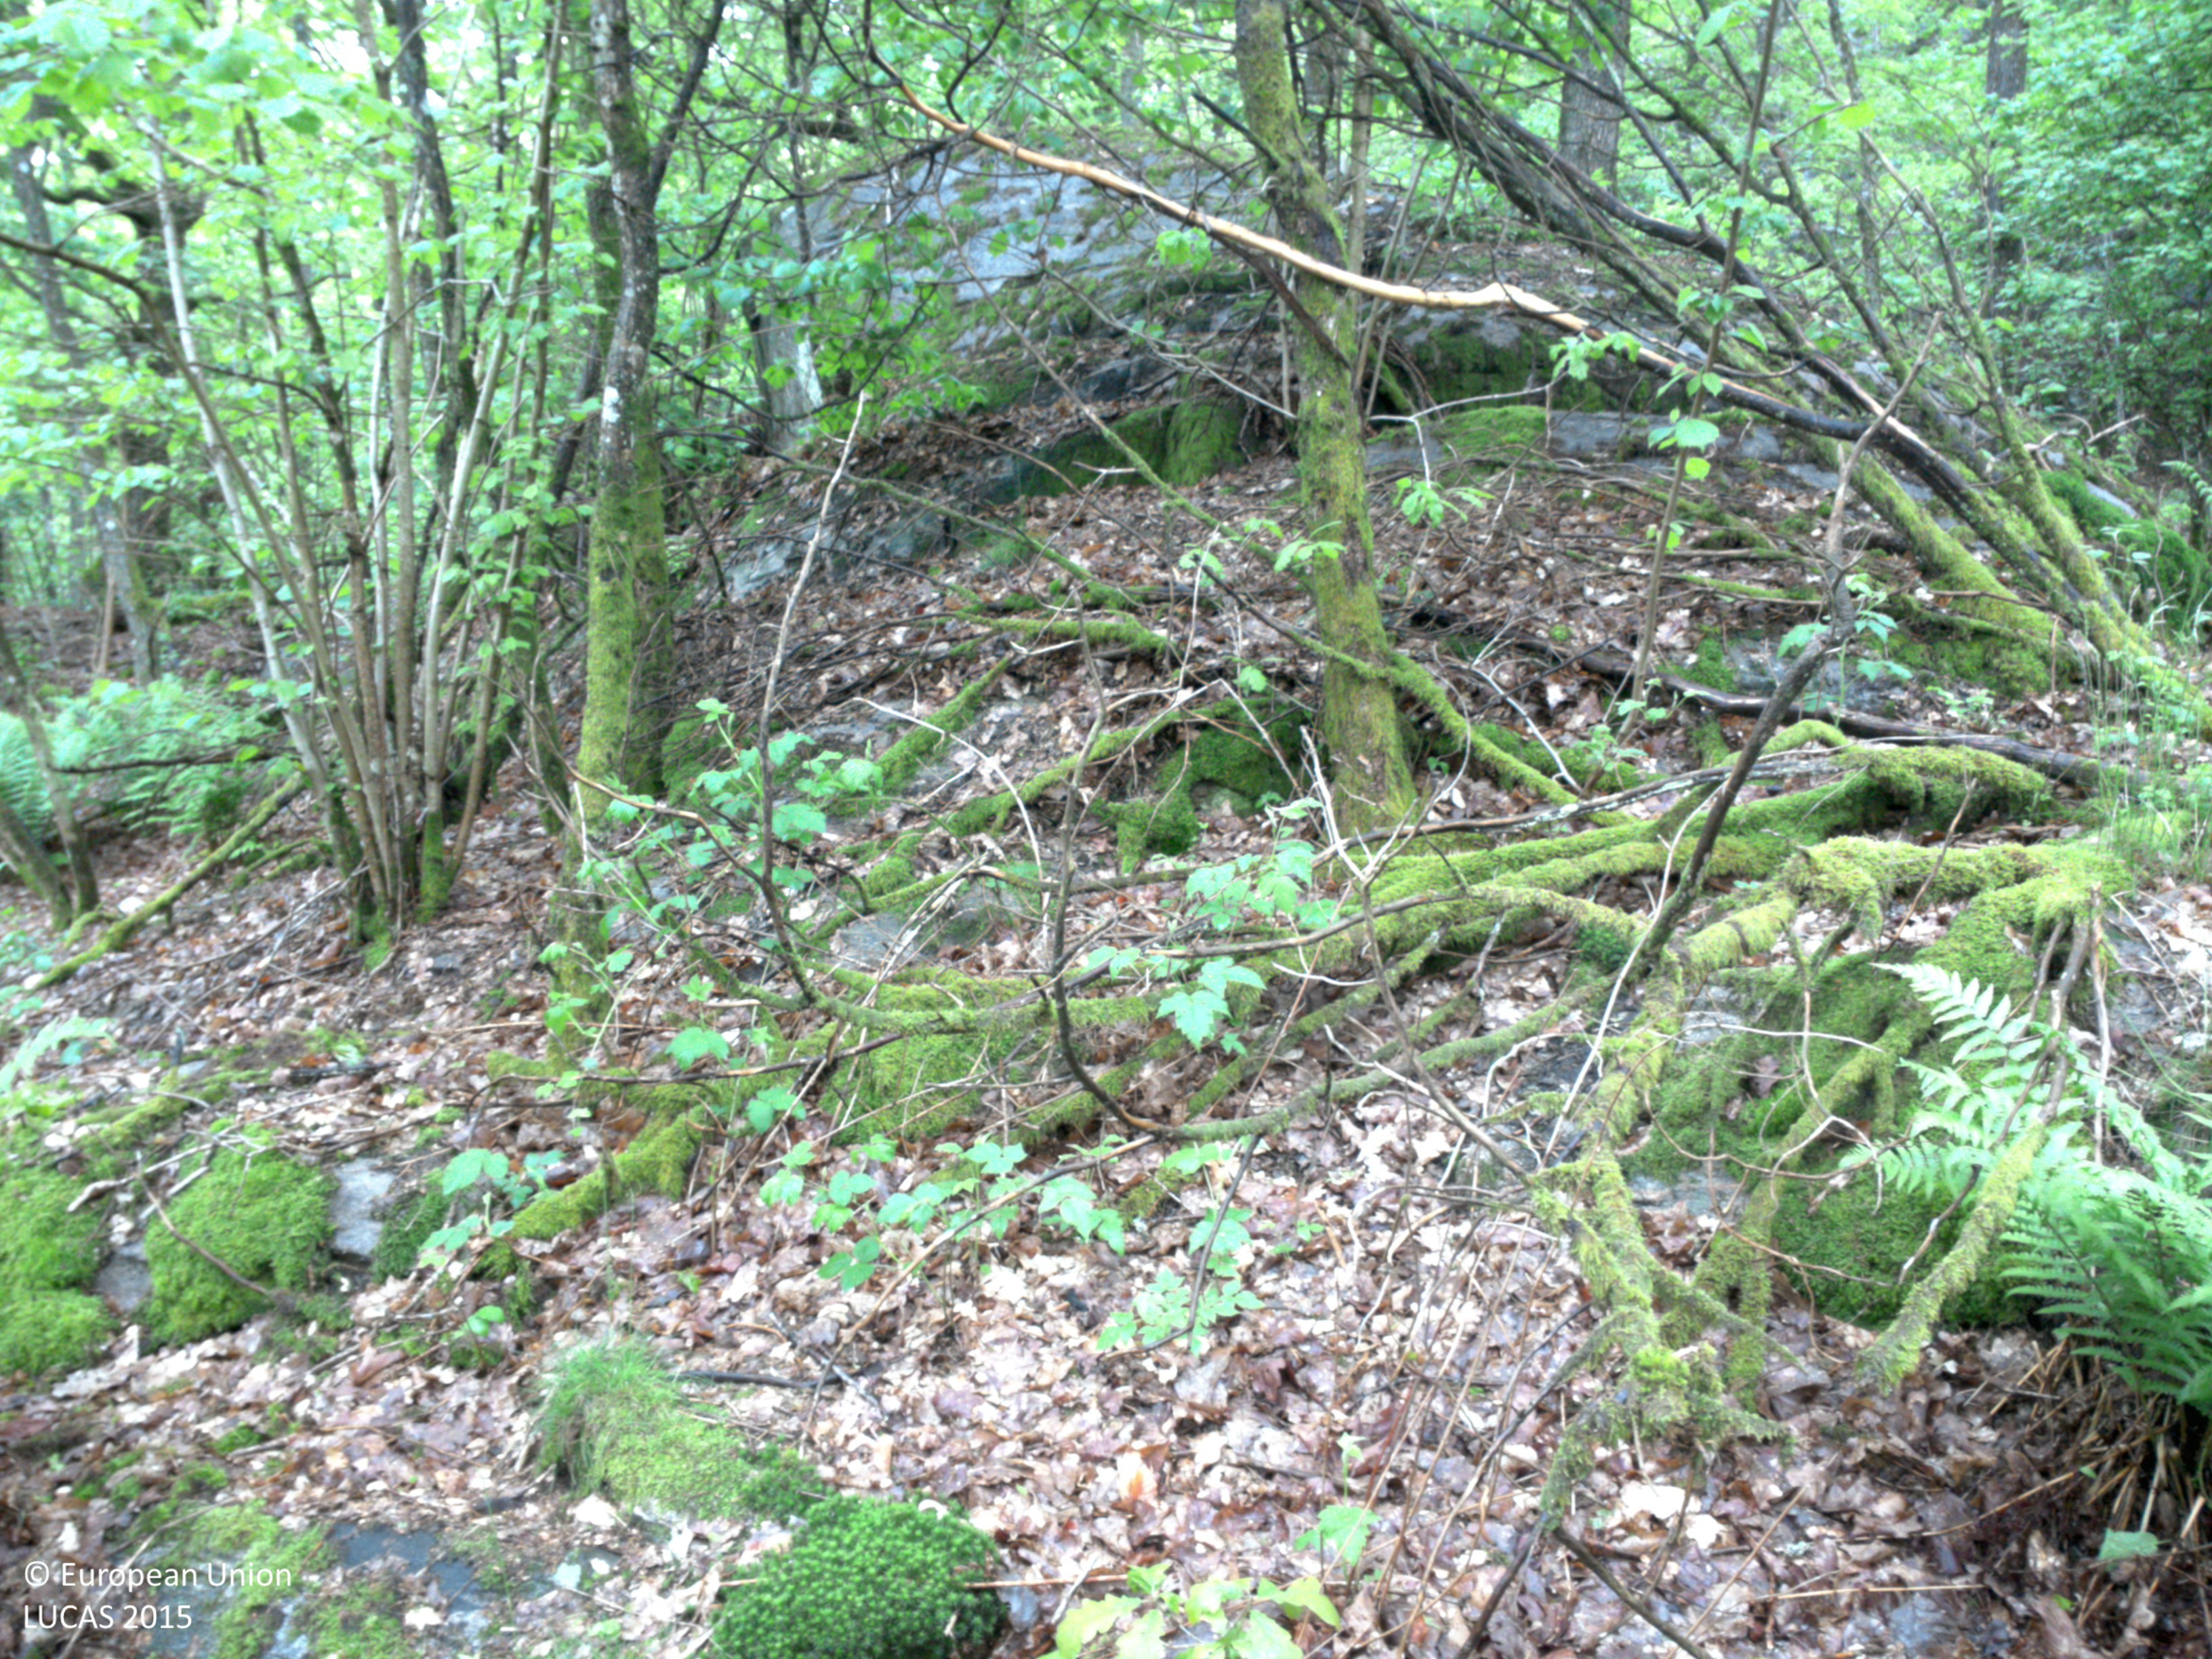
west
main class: Woodland
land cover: Broadleaved woodland
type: mesophytic deciduous forest
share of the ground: 50 - 75 %
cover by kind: broadleaved forest trees 70 %, herbaceous plants 20 %, shrubs 10 %
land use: Amenities, museums, leisure
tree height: > 5 m
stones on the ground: 10 - 25 %
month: June
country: SE
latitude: 57.8812
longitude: 11.9695
